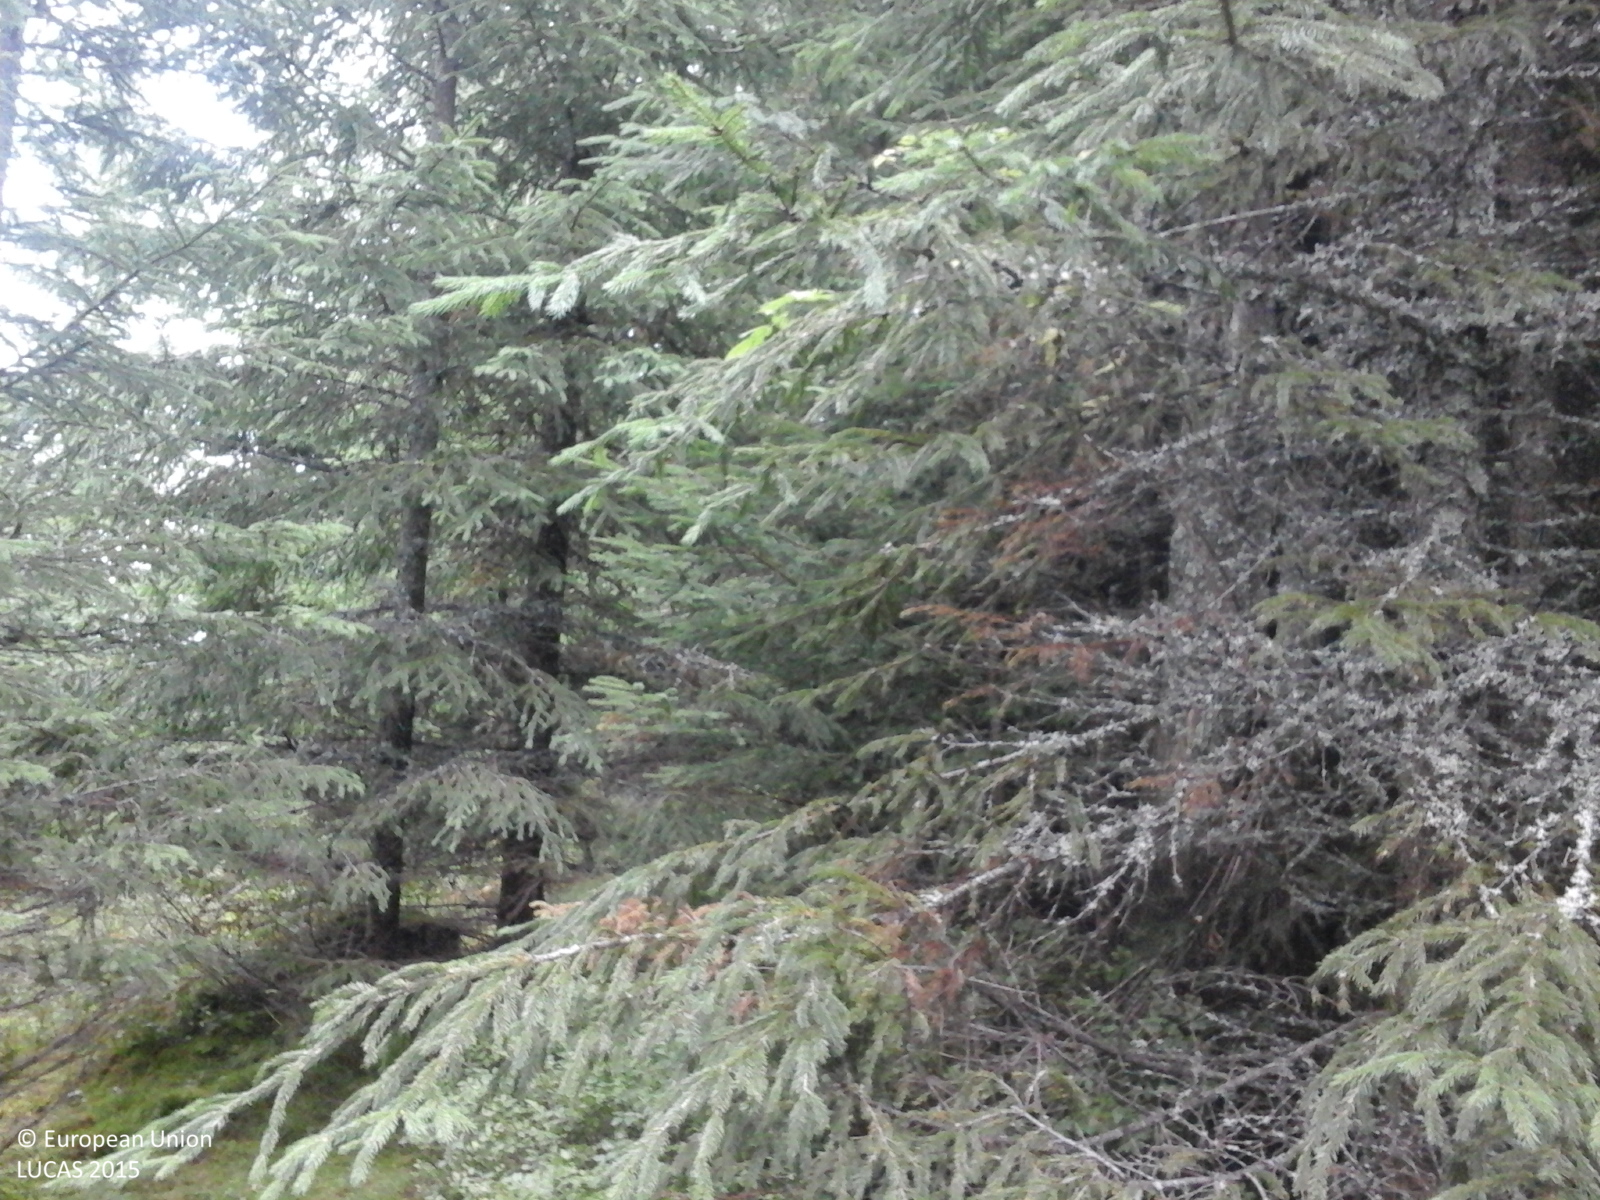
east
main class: Woodland
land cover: Spruce dominated coniferous woodland
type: alpine coniferous forest
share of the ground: > 75 %
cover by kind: coniferous forest trees 100 %
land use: Forestry
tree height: > 5 m
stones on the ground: < 10 %
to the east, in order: Spruce dominated coniferous woodland; Tracks; Spruce dominated coniferous woodland; Tracks; Spruce dominated coniferous woodland
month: September
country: RO
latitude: 46.5469
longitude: 22.9303
